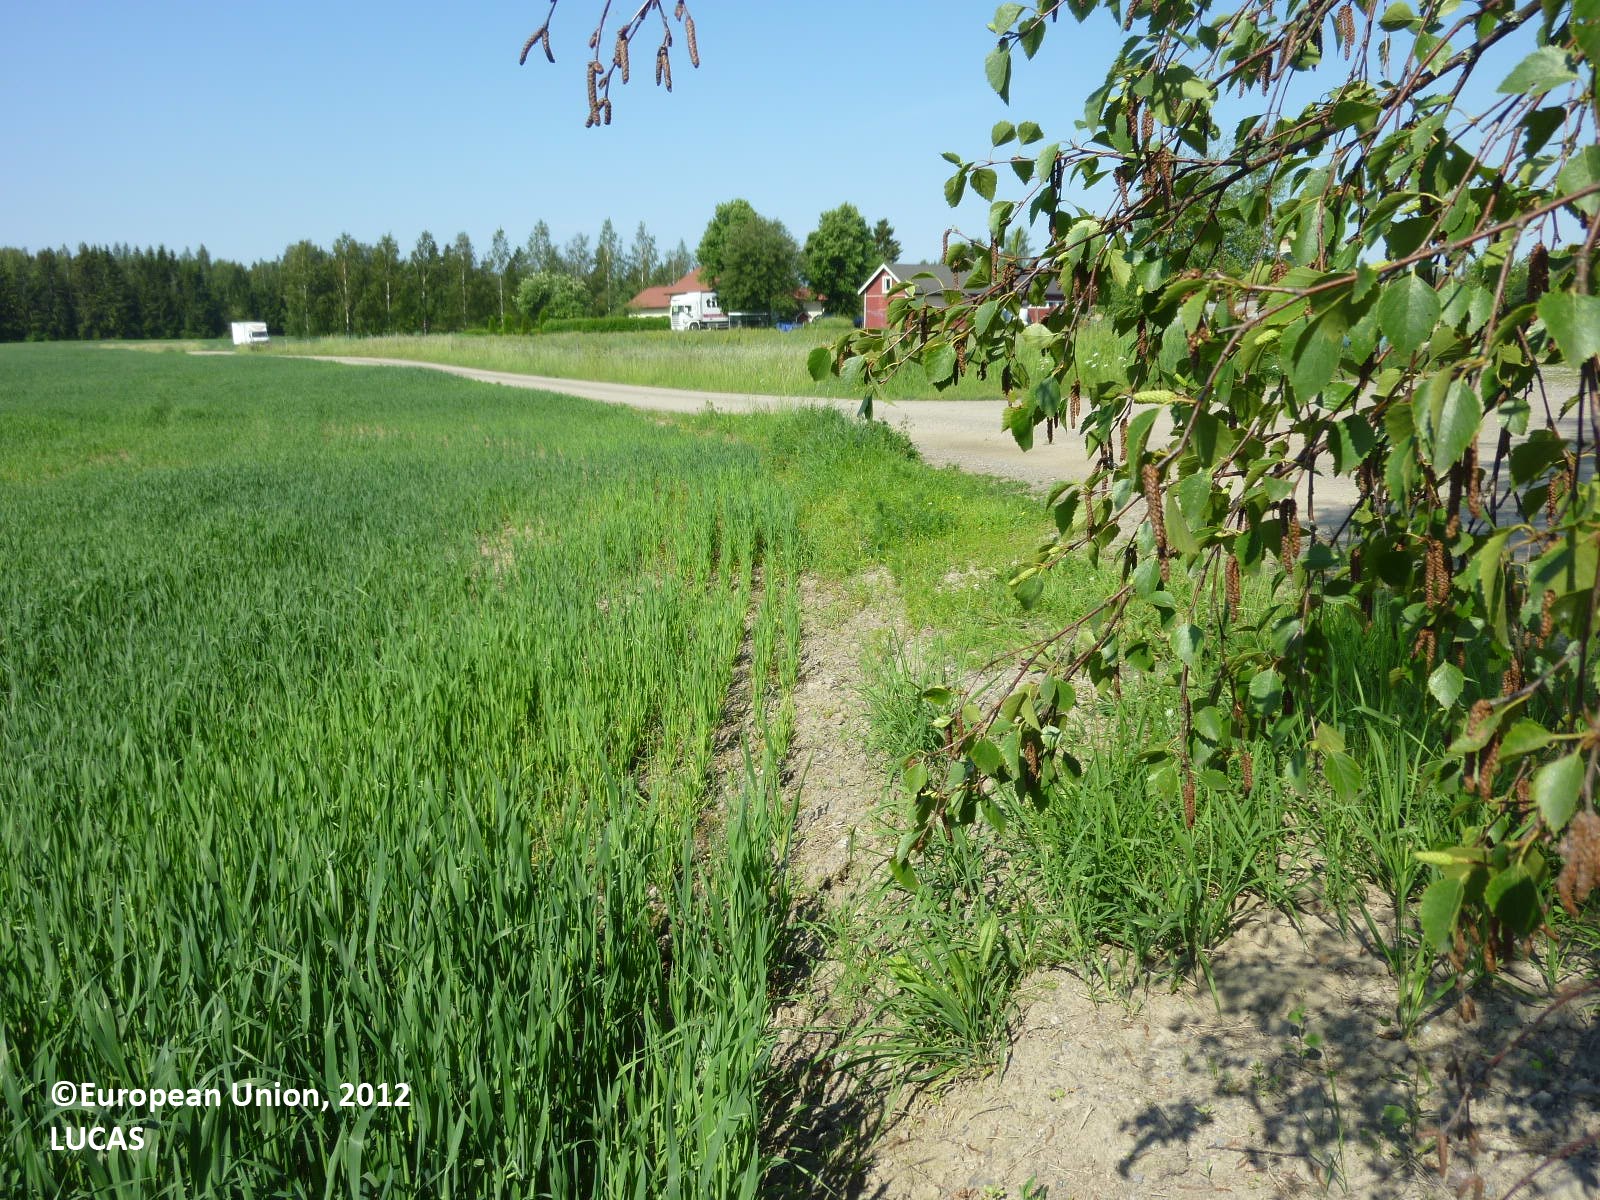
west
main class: Cropland
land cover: Oats
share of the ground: > 75 %
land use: Agriculture (excluding fallow land and kitchen gardens)
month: July
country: FI
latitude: 61.2931
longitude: 22.3997
